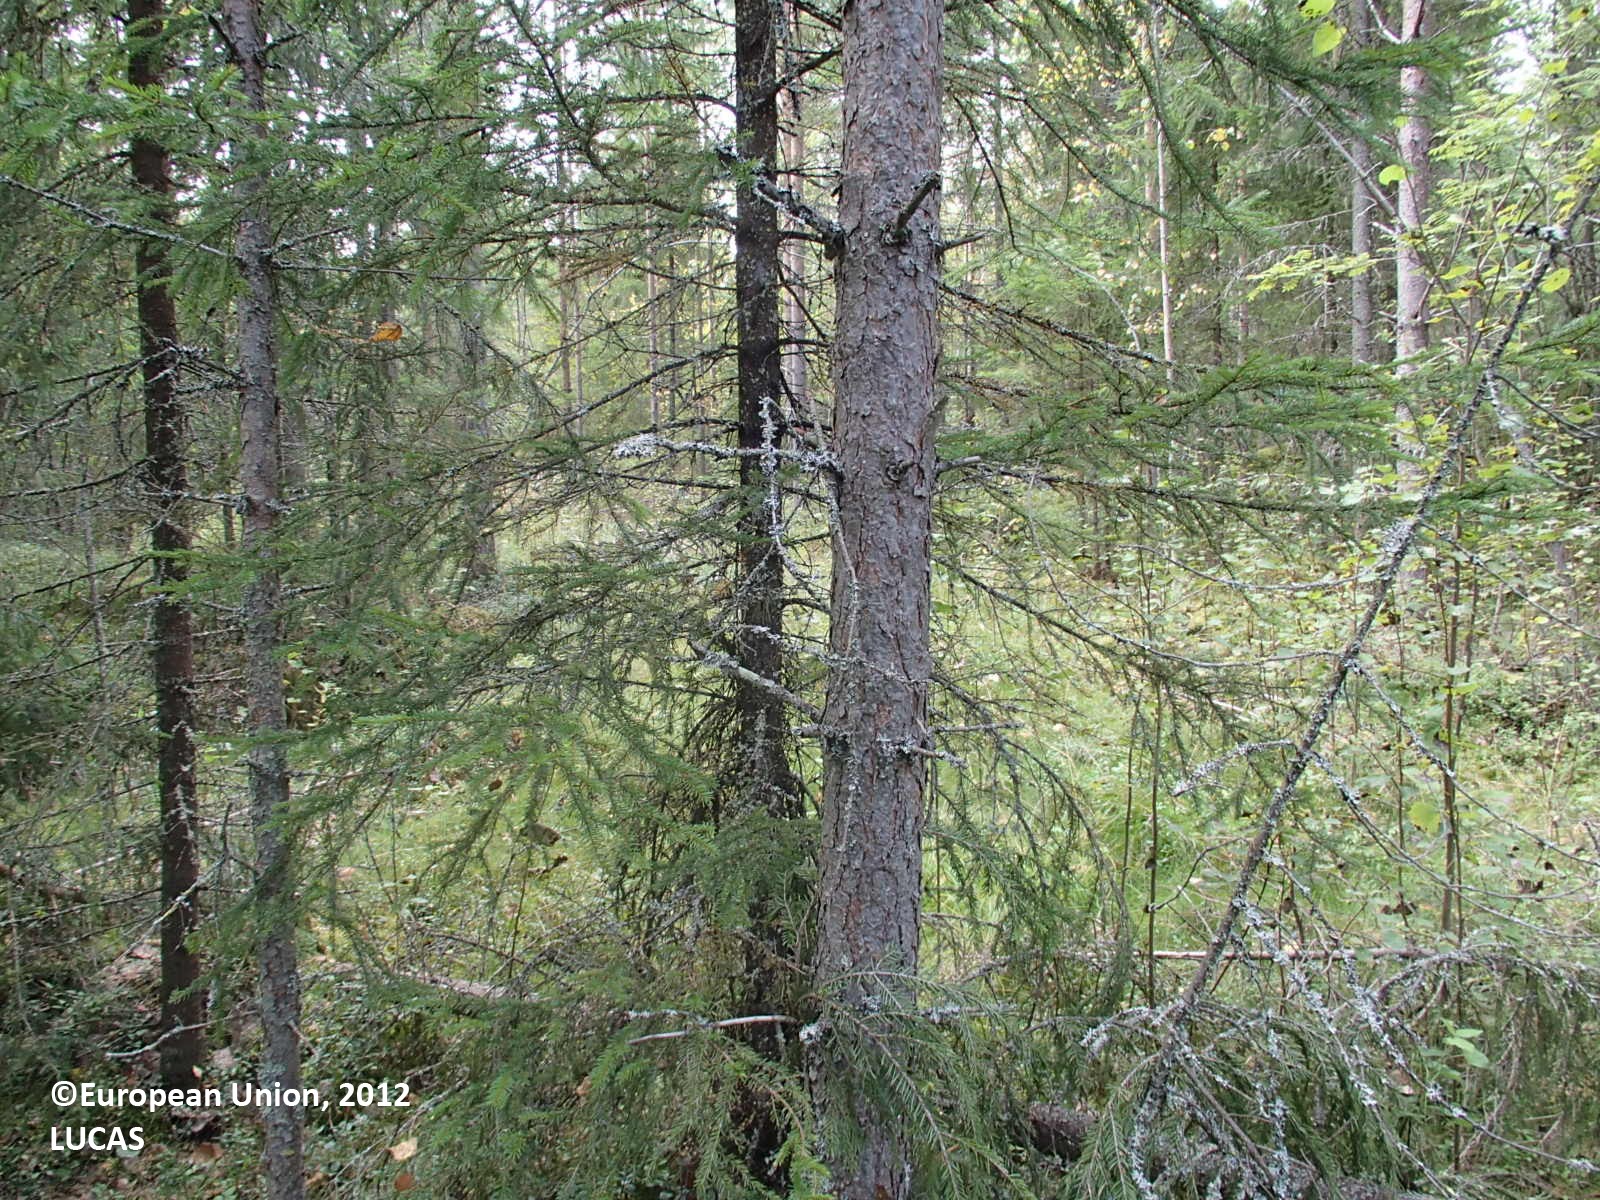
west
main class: Woodland
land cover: Other coniferous woodland
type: boreal forest
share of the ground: > 75 %
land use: Forestry
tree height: > 5 m
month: August
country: FI
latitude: 63.6640
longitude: 27.0924
